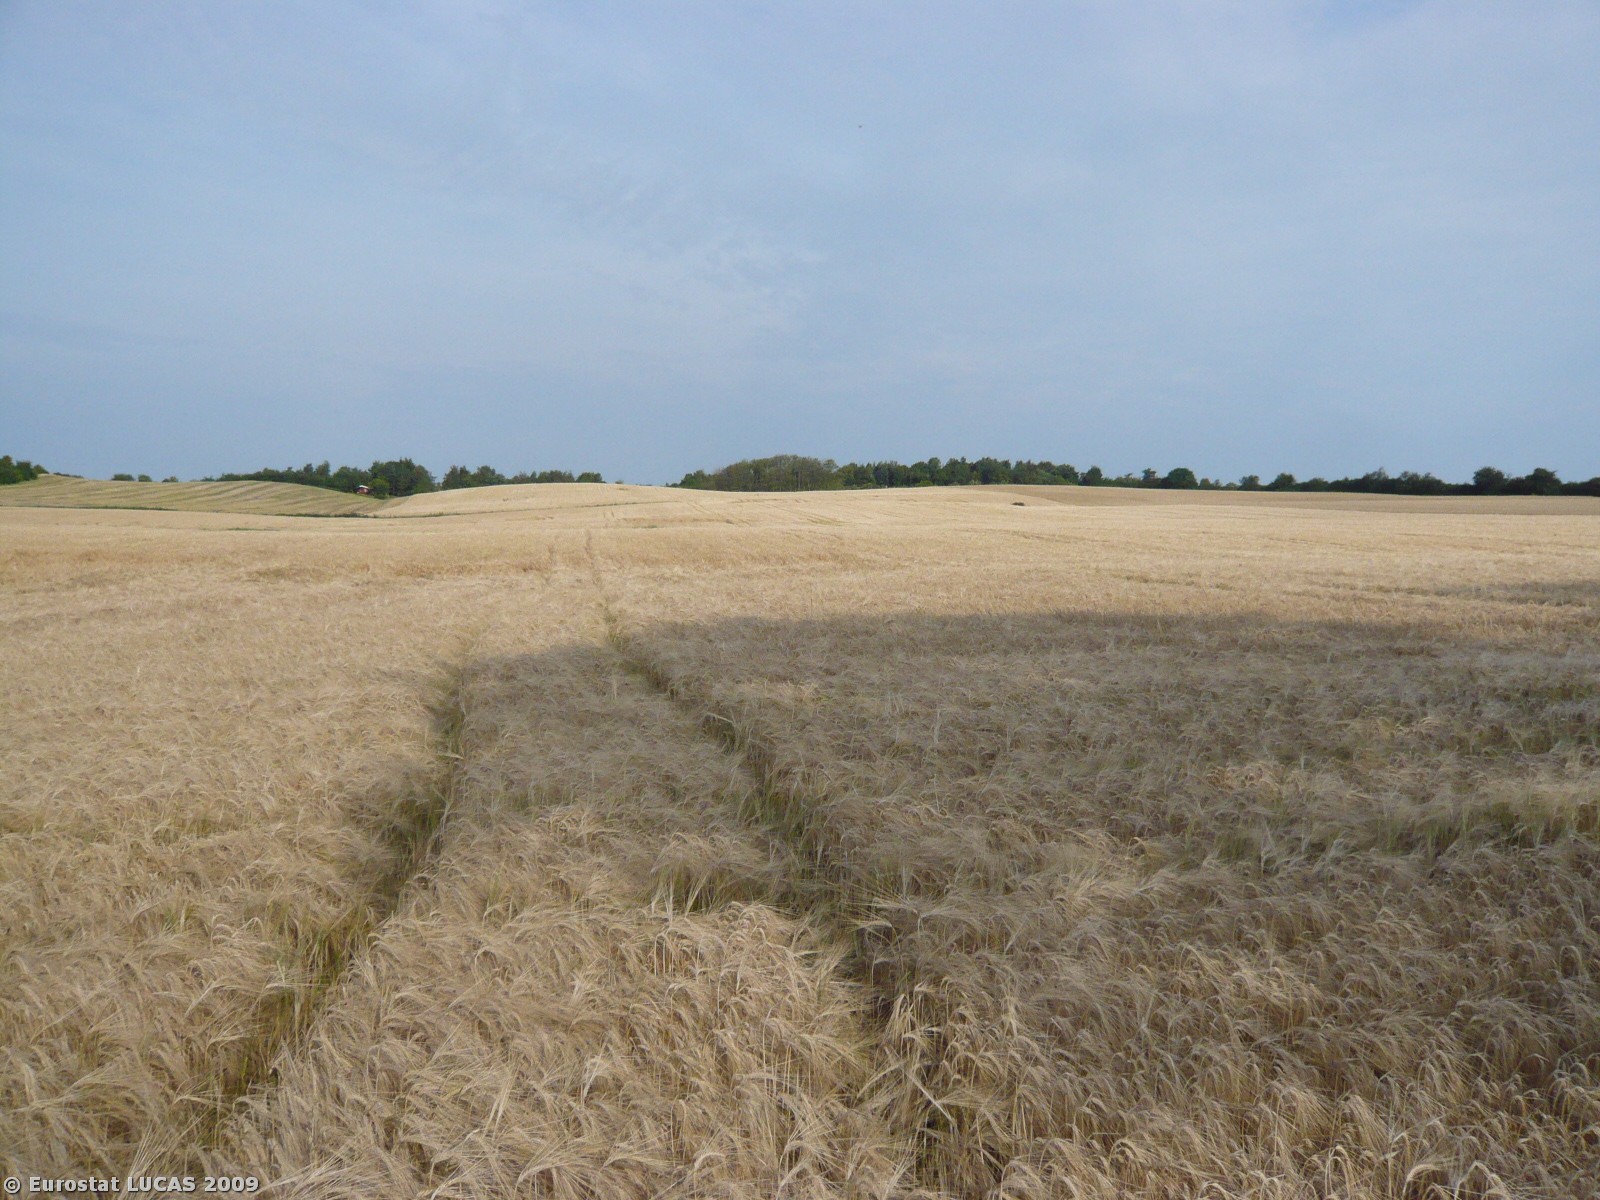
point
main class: Cropland
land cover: Barley
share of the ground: > 75 %
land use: Agriculture (excluding fallow land and kitchen gardens)
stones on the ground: < 10 %
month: August
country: DK
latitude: 55.9897
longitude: 12.1620
